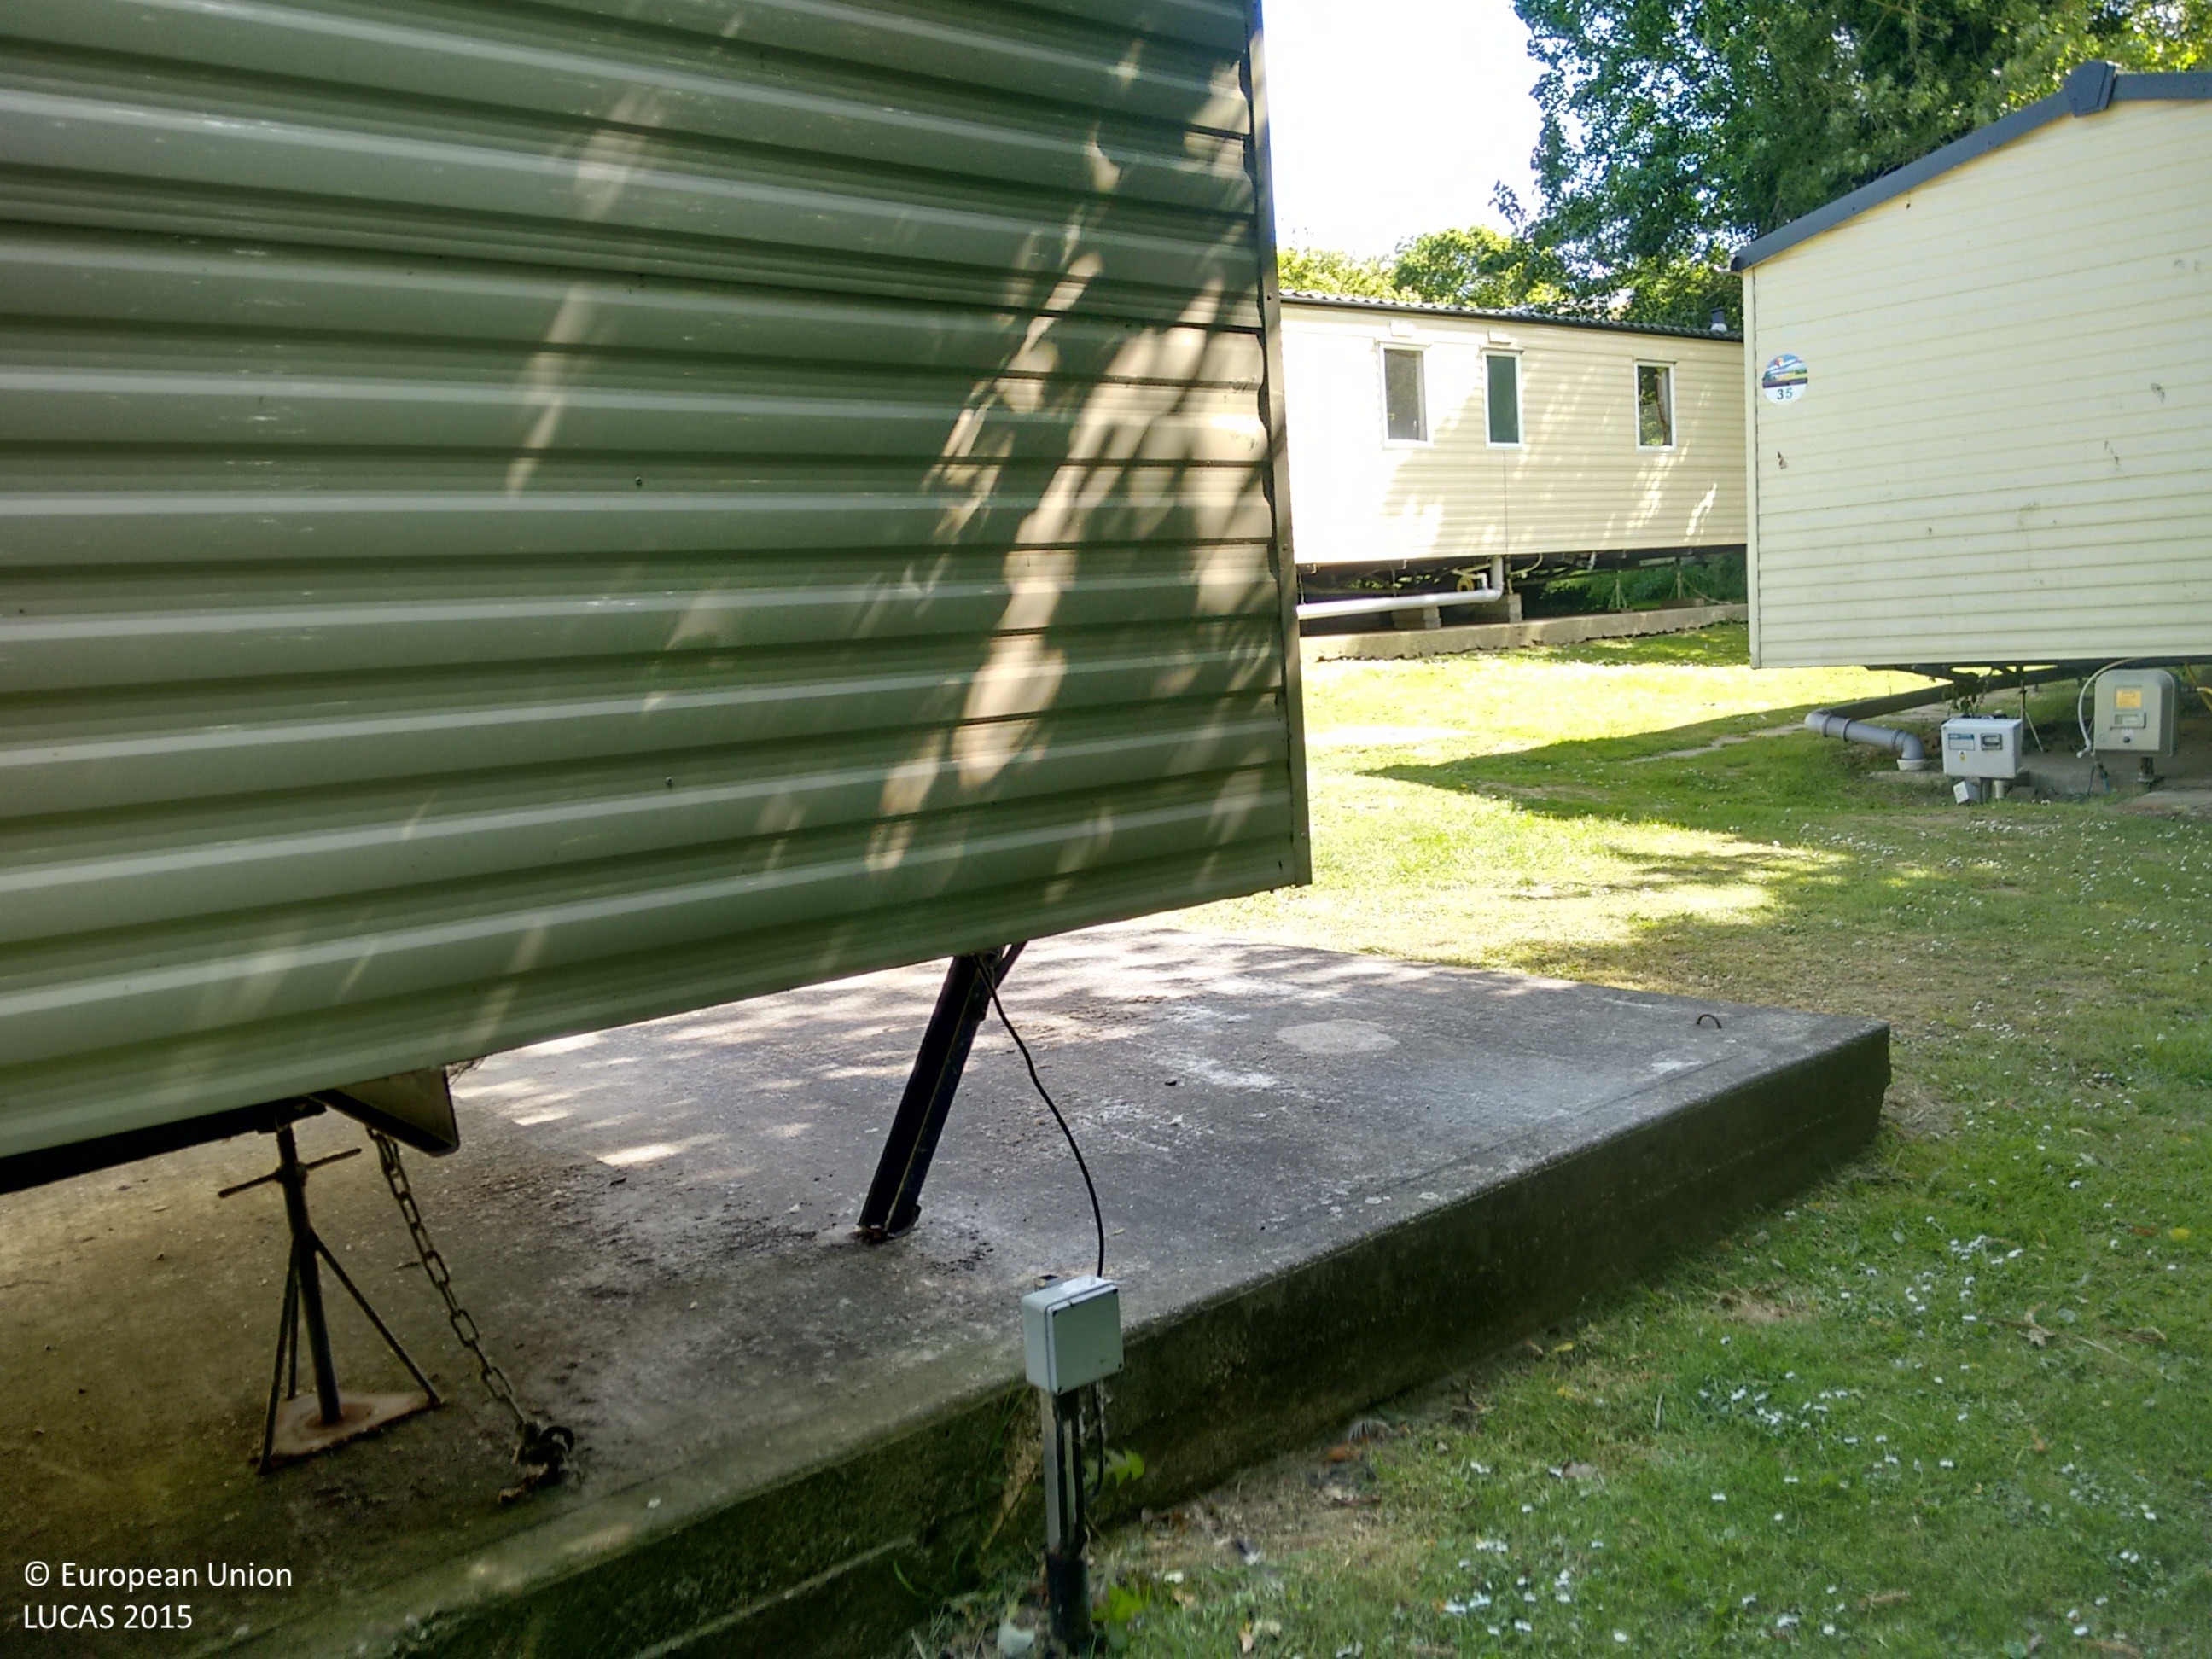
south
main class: Woodland
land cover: Broadleaved woodland
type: mesophytic deciduous forest
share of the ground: > 75 %
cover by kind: broadleaved forest trees 60 %, shrubs 40 %
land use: Semi-natural and natural areas not in use
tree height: > 5 m
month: June
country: GB
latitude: 50.8572
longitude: 0.5255
